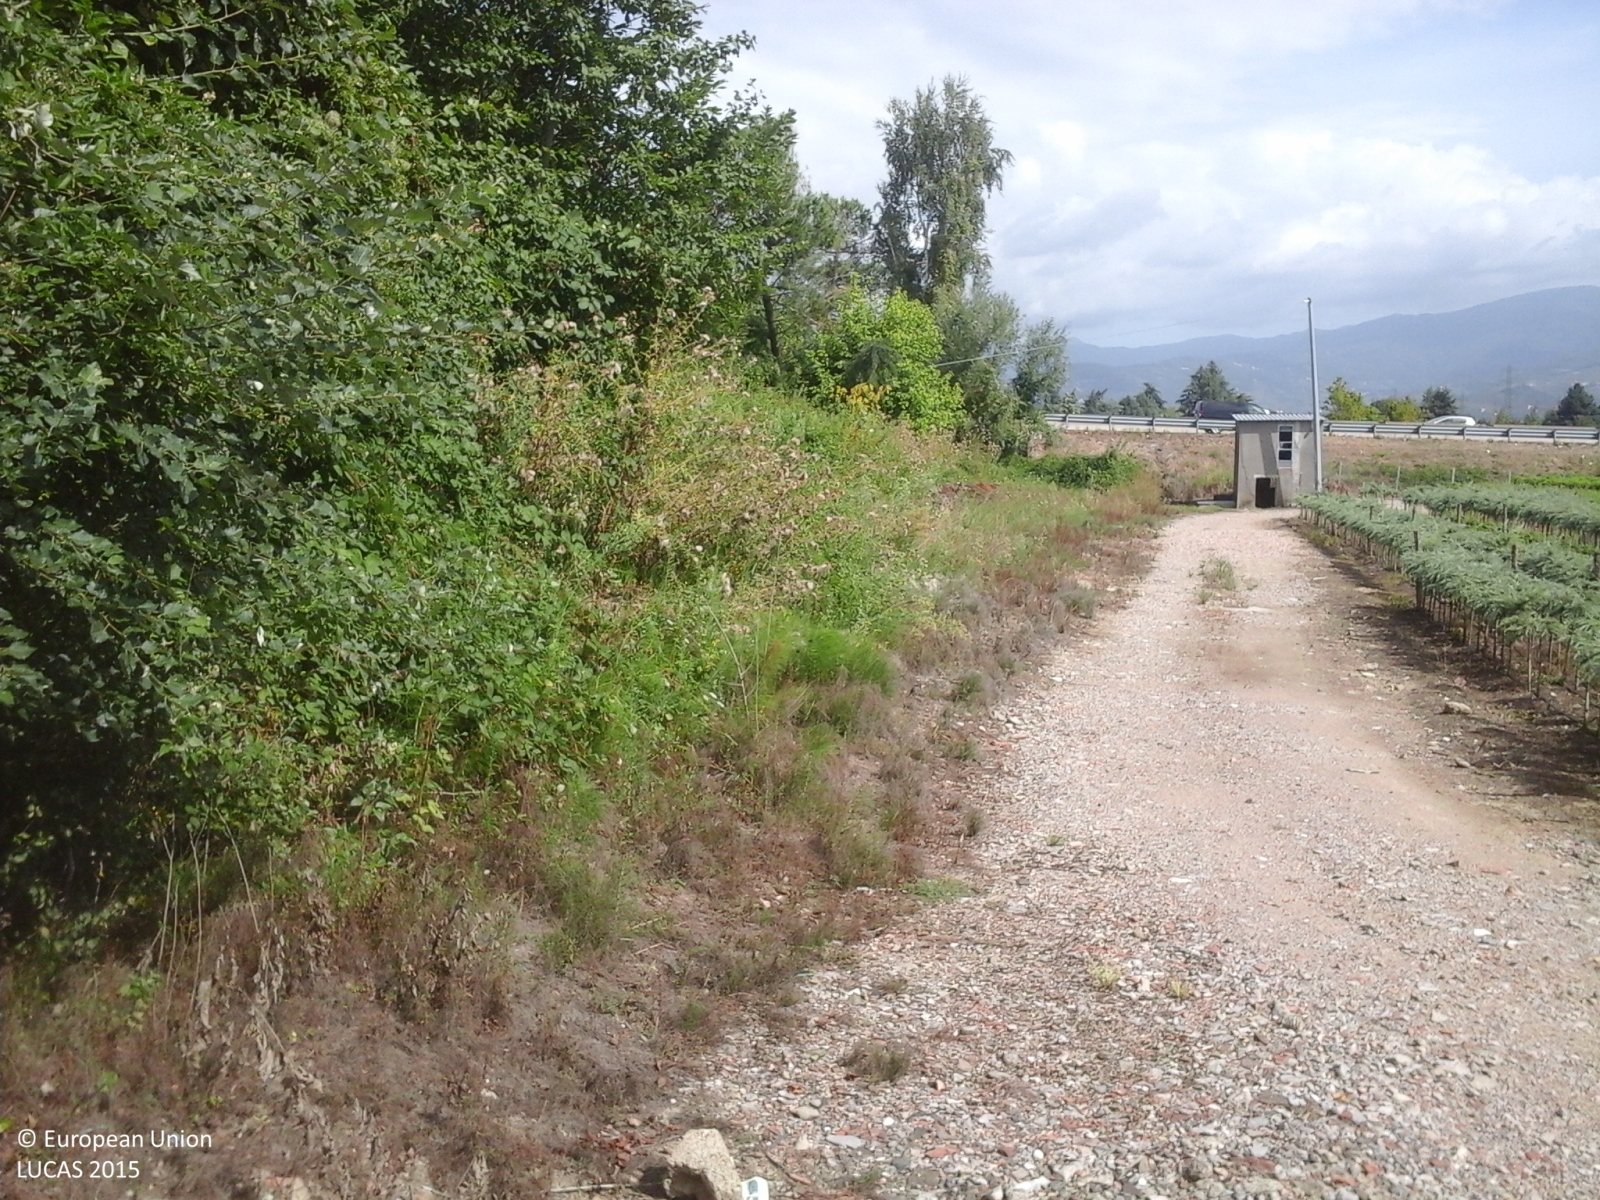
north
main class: Woodland
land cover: Broadleaved woodland
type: thermophilous deciduous forest
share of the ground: > 75 %
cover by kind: broadleaved forest trees 100 %
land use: Abandoned areas
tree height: > 5 m
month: August
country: IT
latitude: 43.9136
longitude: 10.9067
